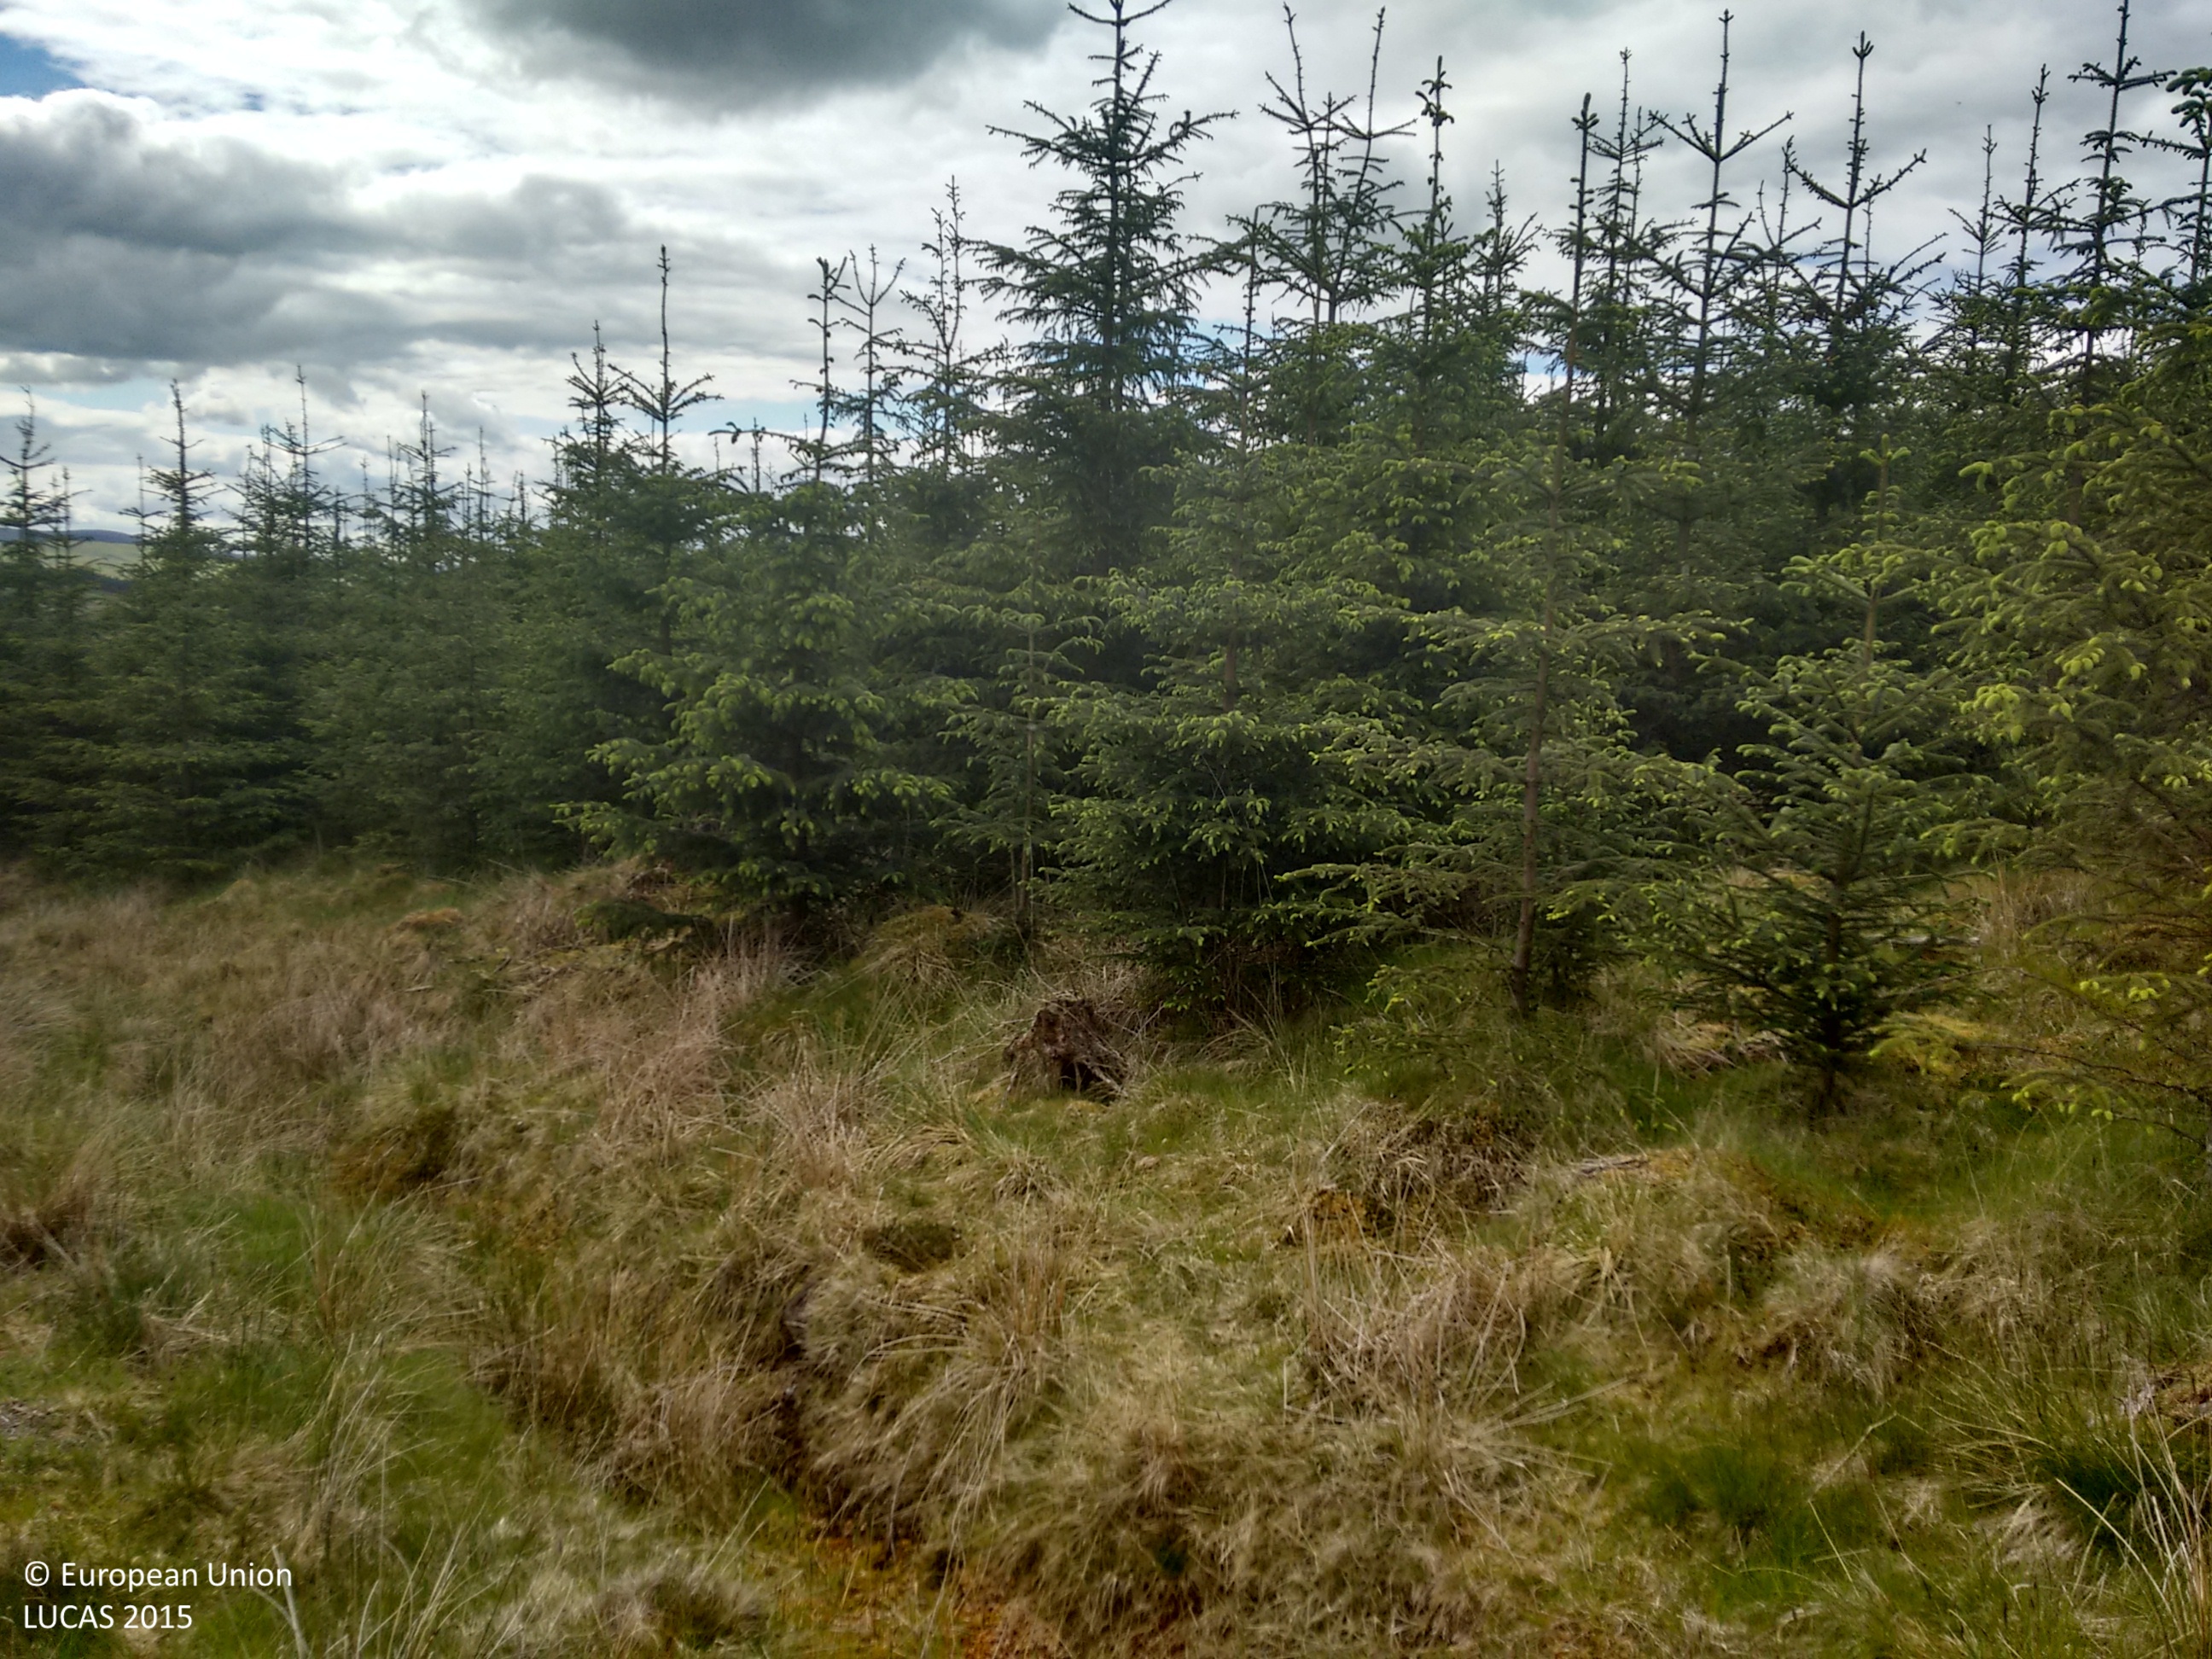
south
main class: Woodland
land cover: Spruce dominated coniferous woodland
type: exotic forest
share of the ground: > 75 %
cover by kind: coniferous forest trees 85 %, herbaceous plants 15 %
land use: Forestry
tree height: < 5 m
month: June
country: GB
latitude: 55.7345
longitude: -3.2438
